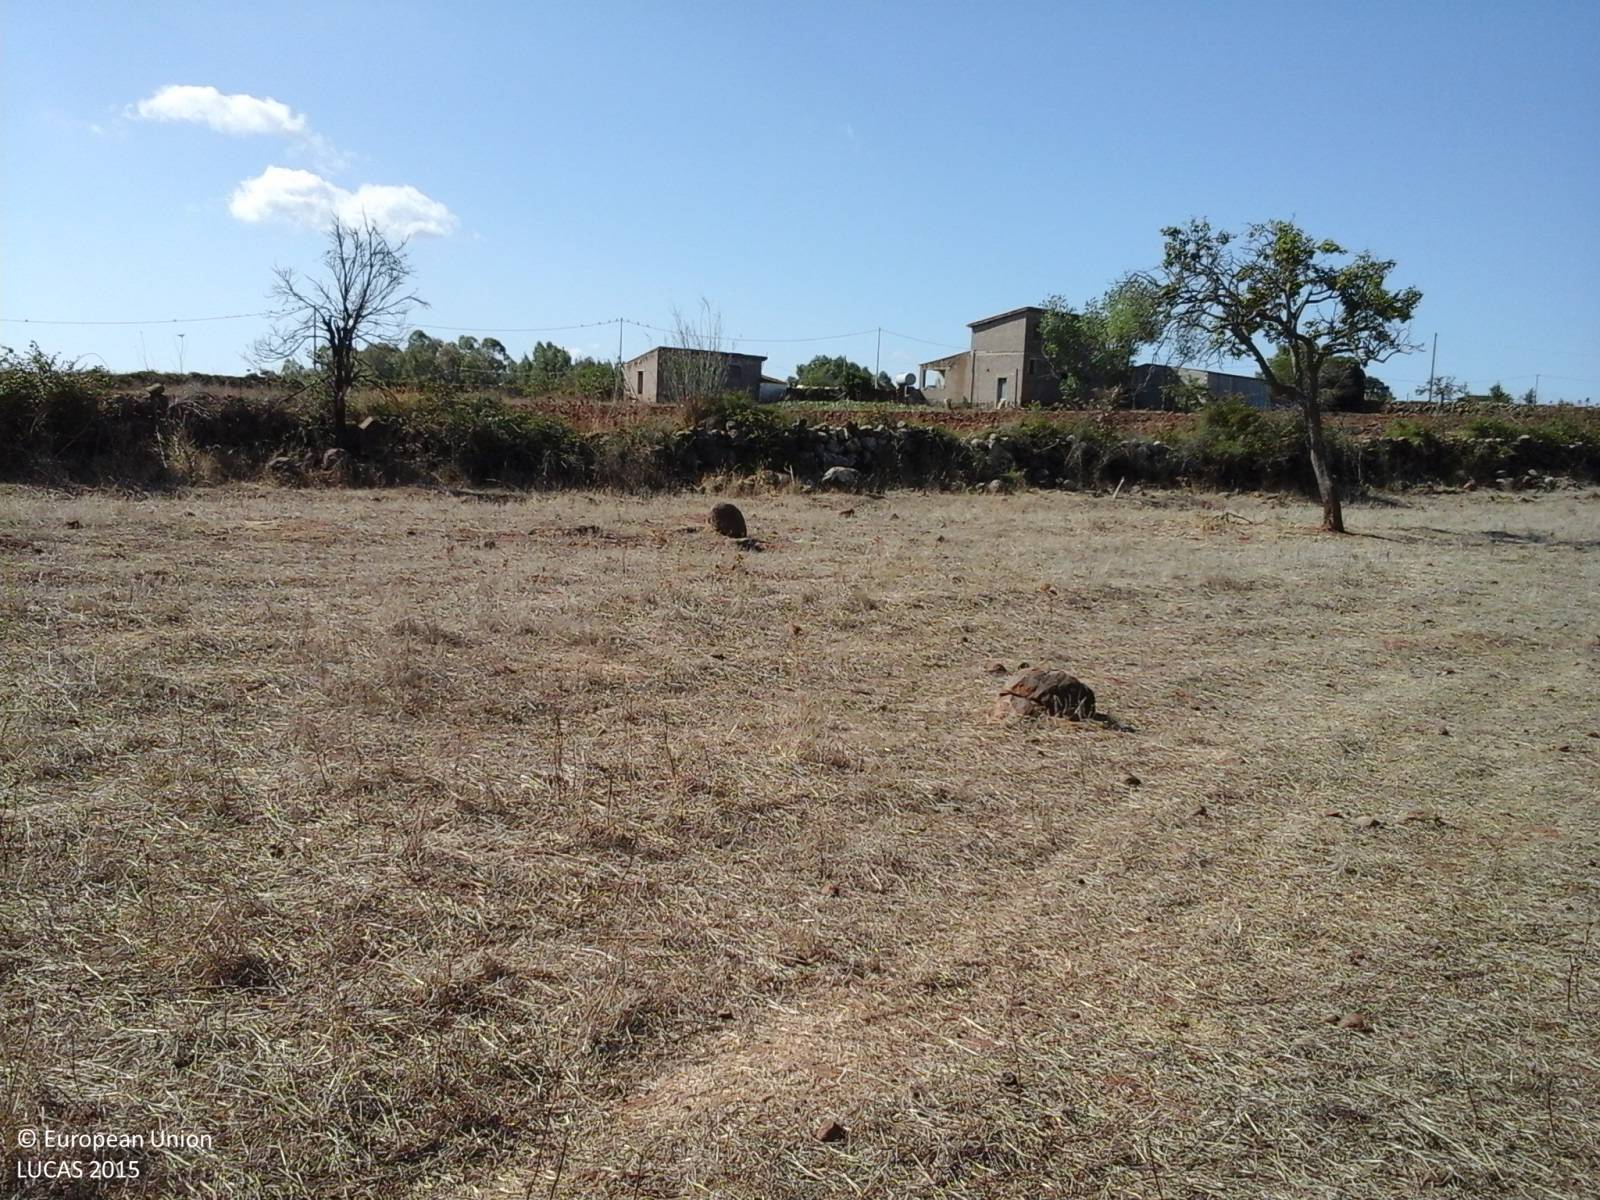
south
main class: Grassland
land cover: Grassland without tree/shrub cover
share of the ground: 25 - 50 %
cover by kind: herbaceous plants 100 %
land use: Agriculture (excluding fallow land and kitchen gardens)
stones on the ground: 25 - 50 %
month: August
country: IT
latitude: 40.1157
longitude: 8.8446
